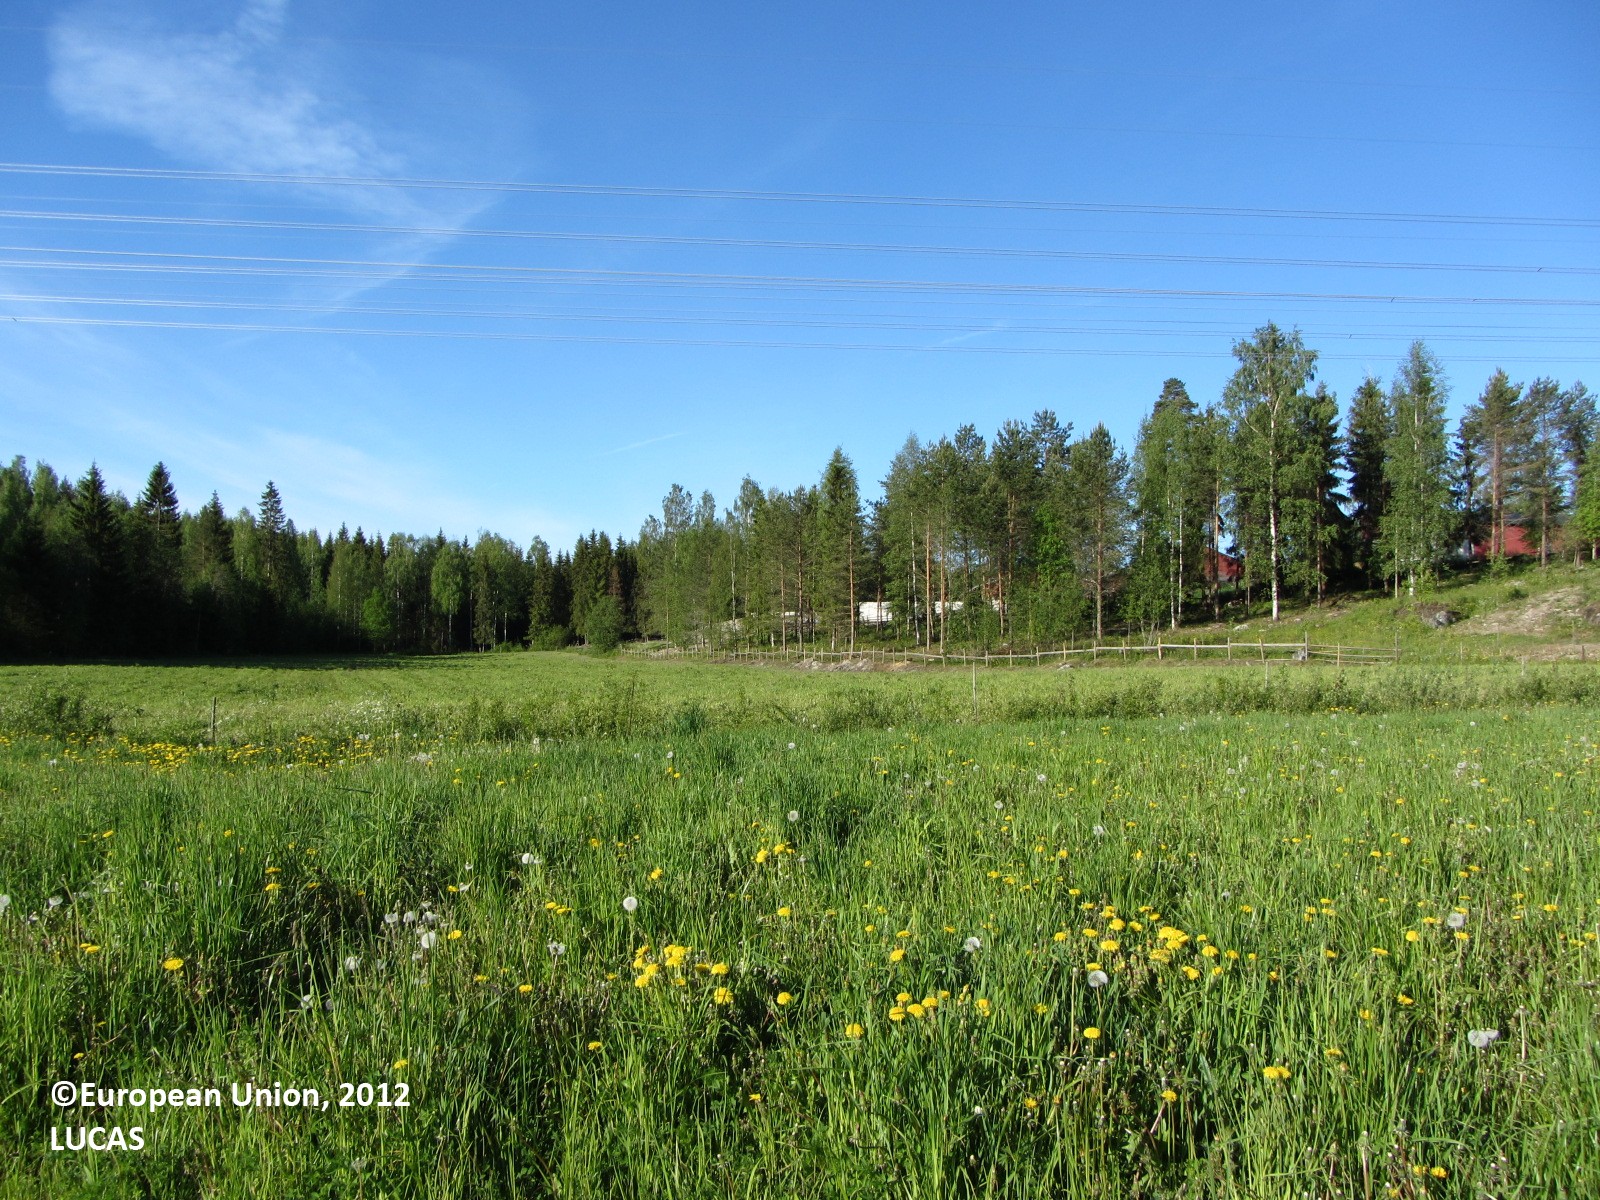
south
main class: Grassland
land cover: Grassland without tree/shrub cover
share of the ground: > 75 %
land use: Agriculture (excluding fallow land and kitchen gardens)
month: June
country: FI
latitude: 61.8331
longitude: 25.2083
